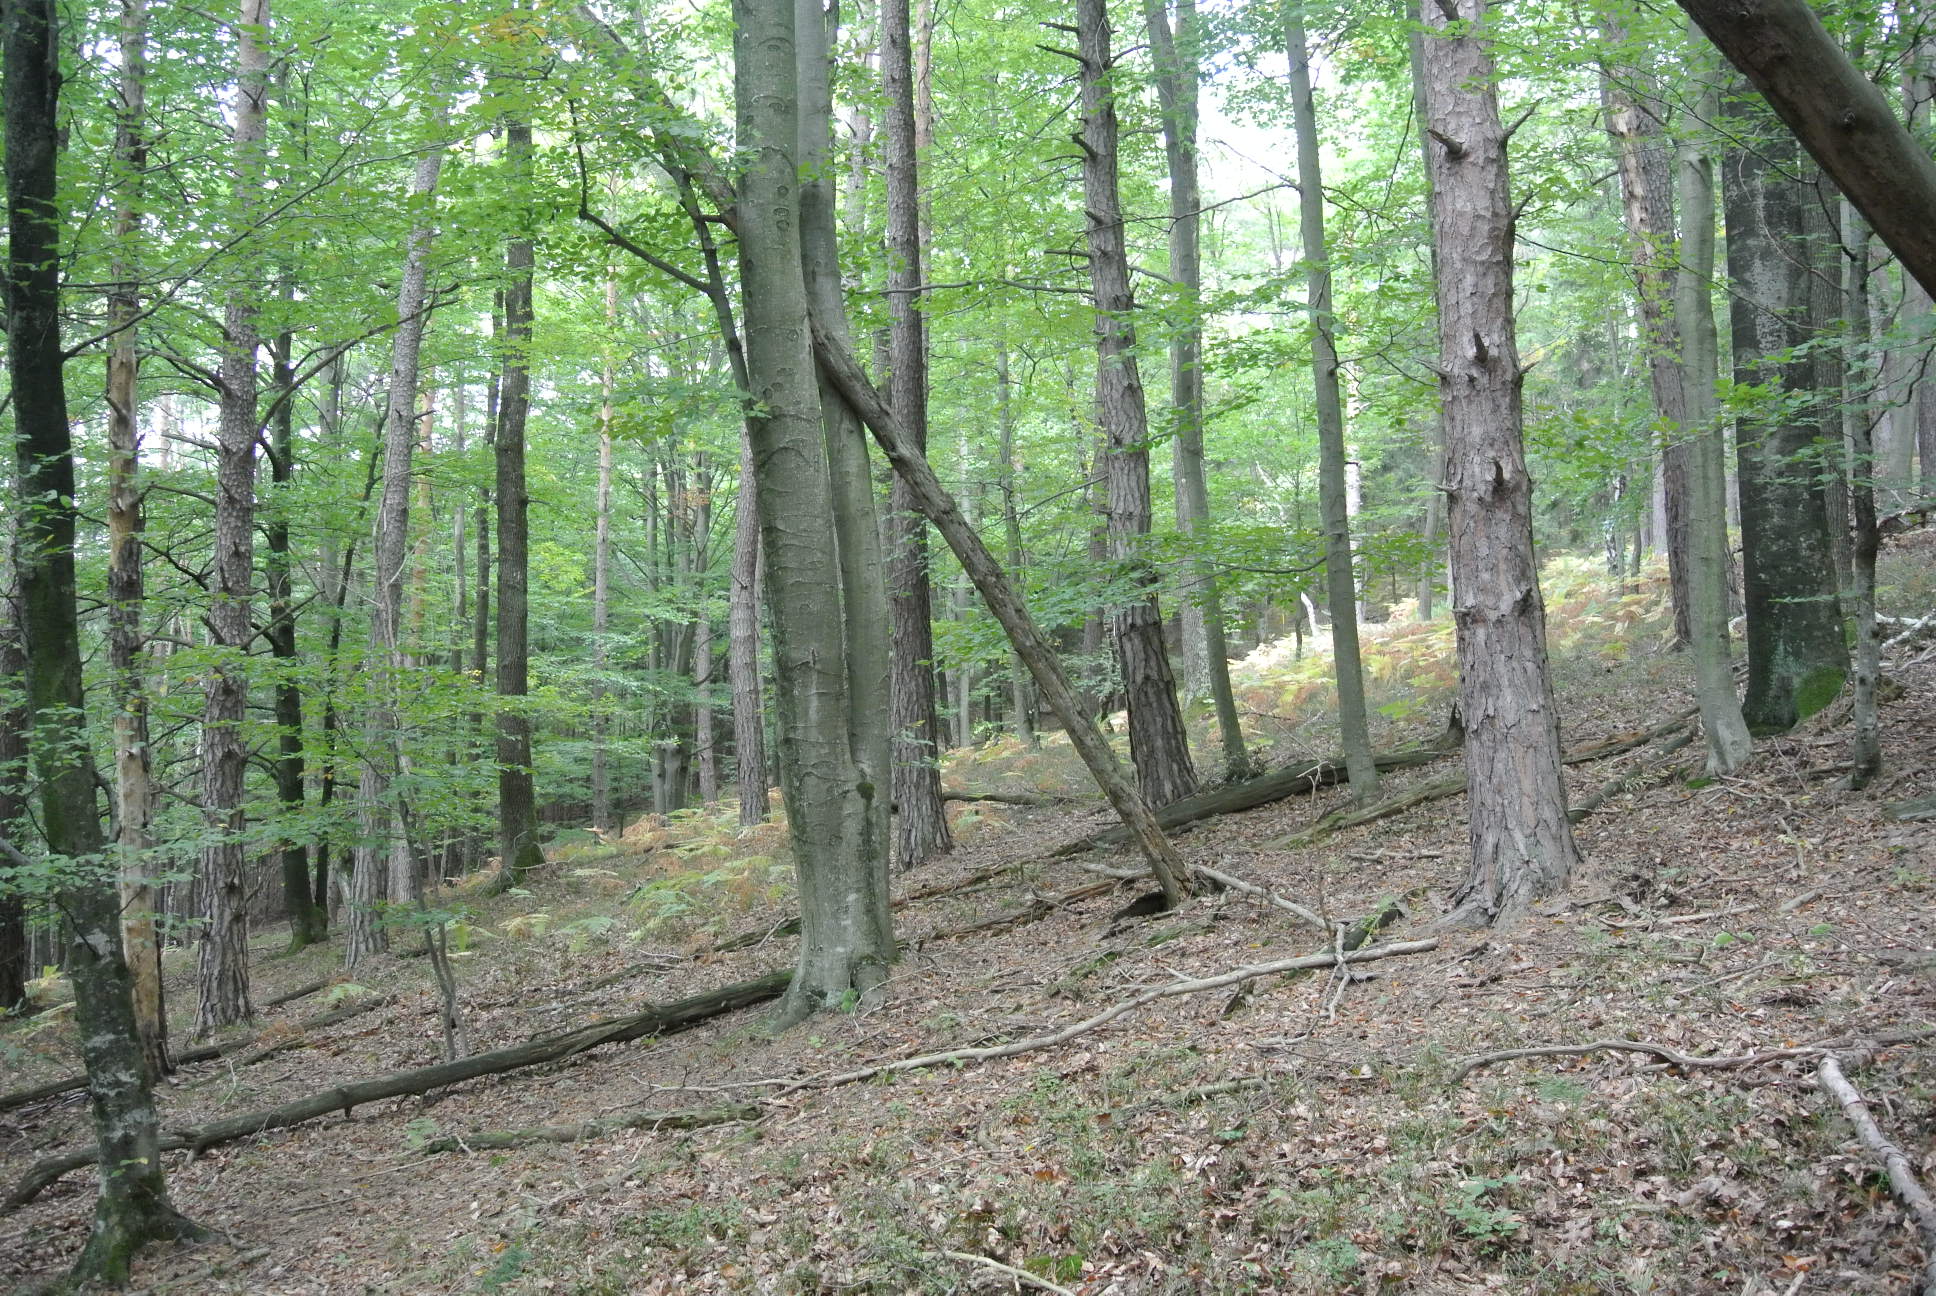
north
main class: Woodland
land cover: Pine dominated mixed woodland
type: alpine coniferous forest
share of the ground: > 75 %
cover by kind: coniferous forest trees 50 %, broadleaved forest trees 50 %
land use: Forestry
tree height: > 5 m
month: September
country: AT
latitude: 47.3876
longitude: 16.4015
